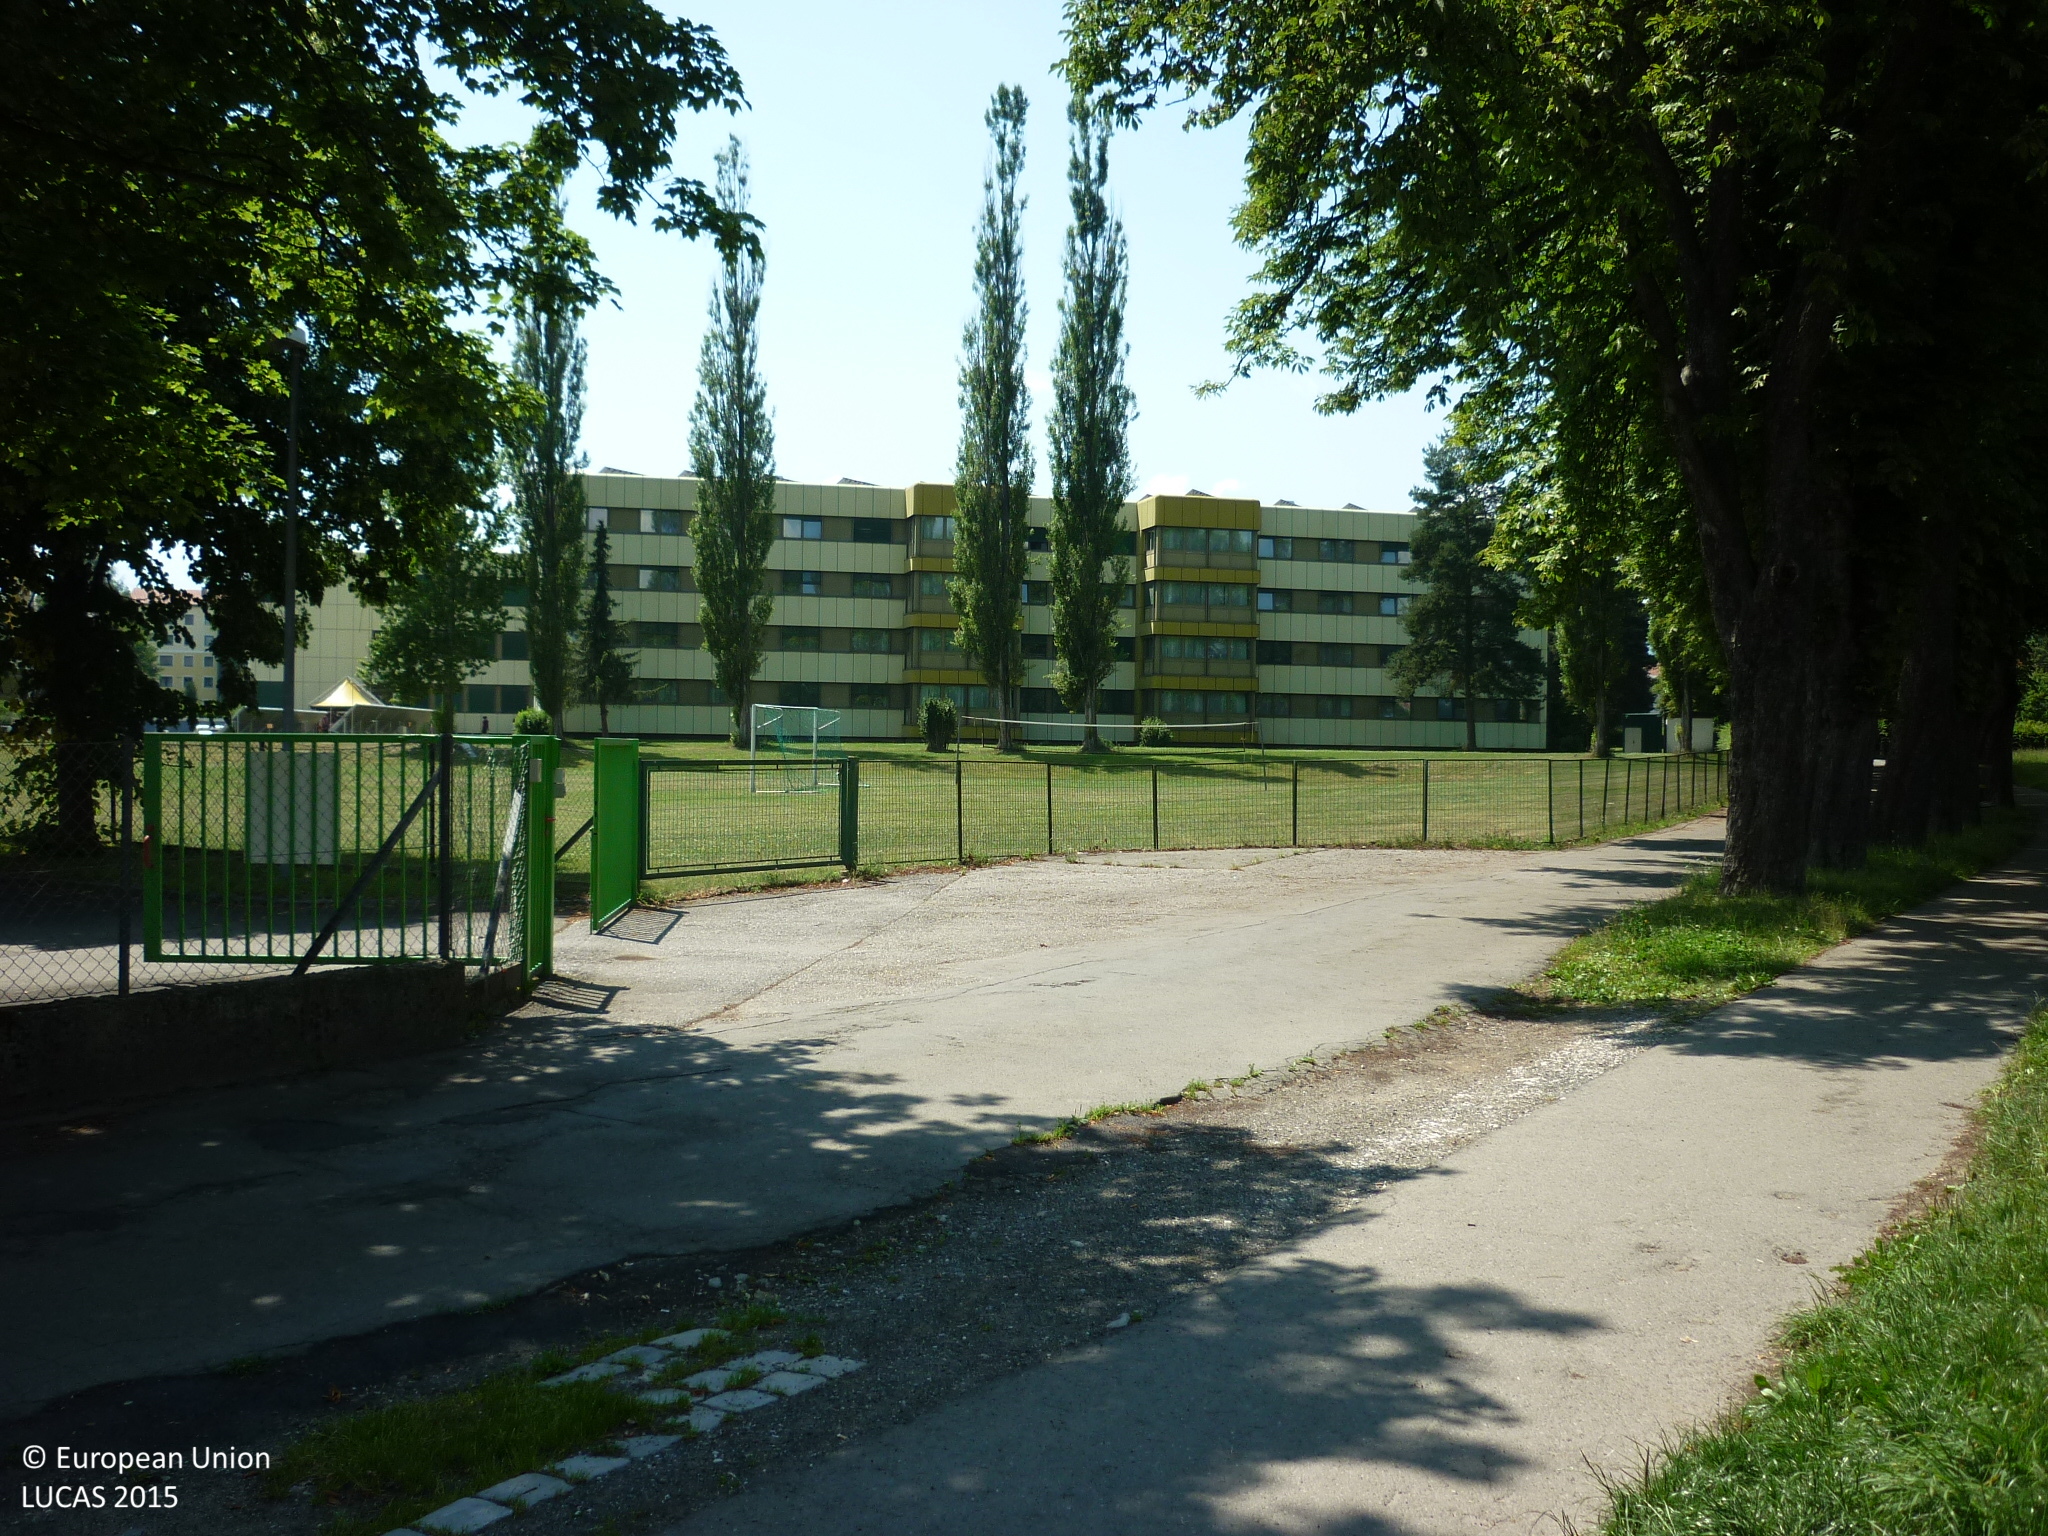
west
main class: Grassland
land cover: Grassland without tree/shrub cover
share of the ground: > 75 %
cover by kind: herbaceous plants 100 %
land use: Amenities, museums, leisure
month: July
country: AT
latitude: 47.2167
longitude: 14.8187
